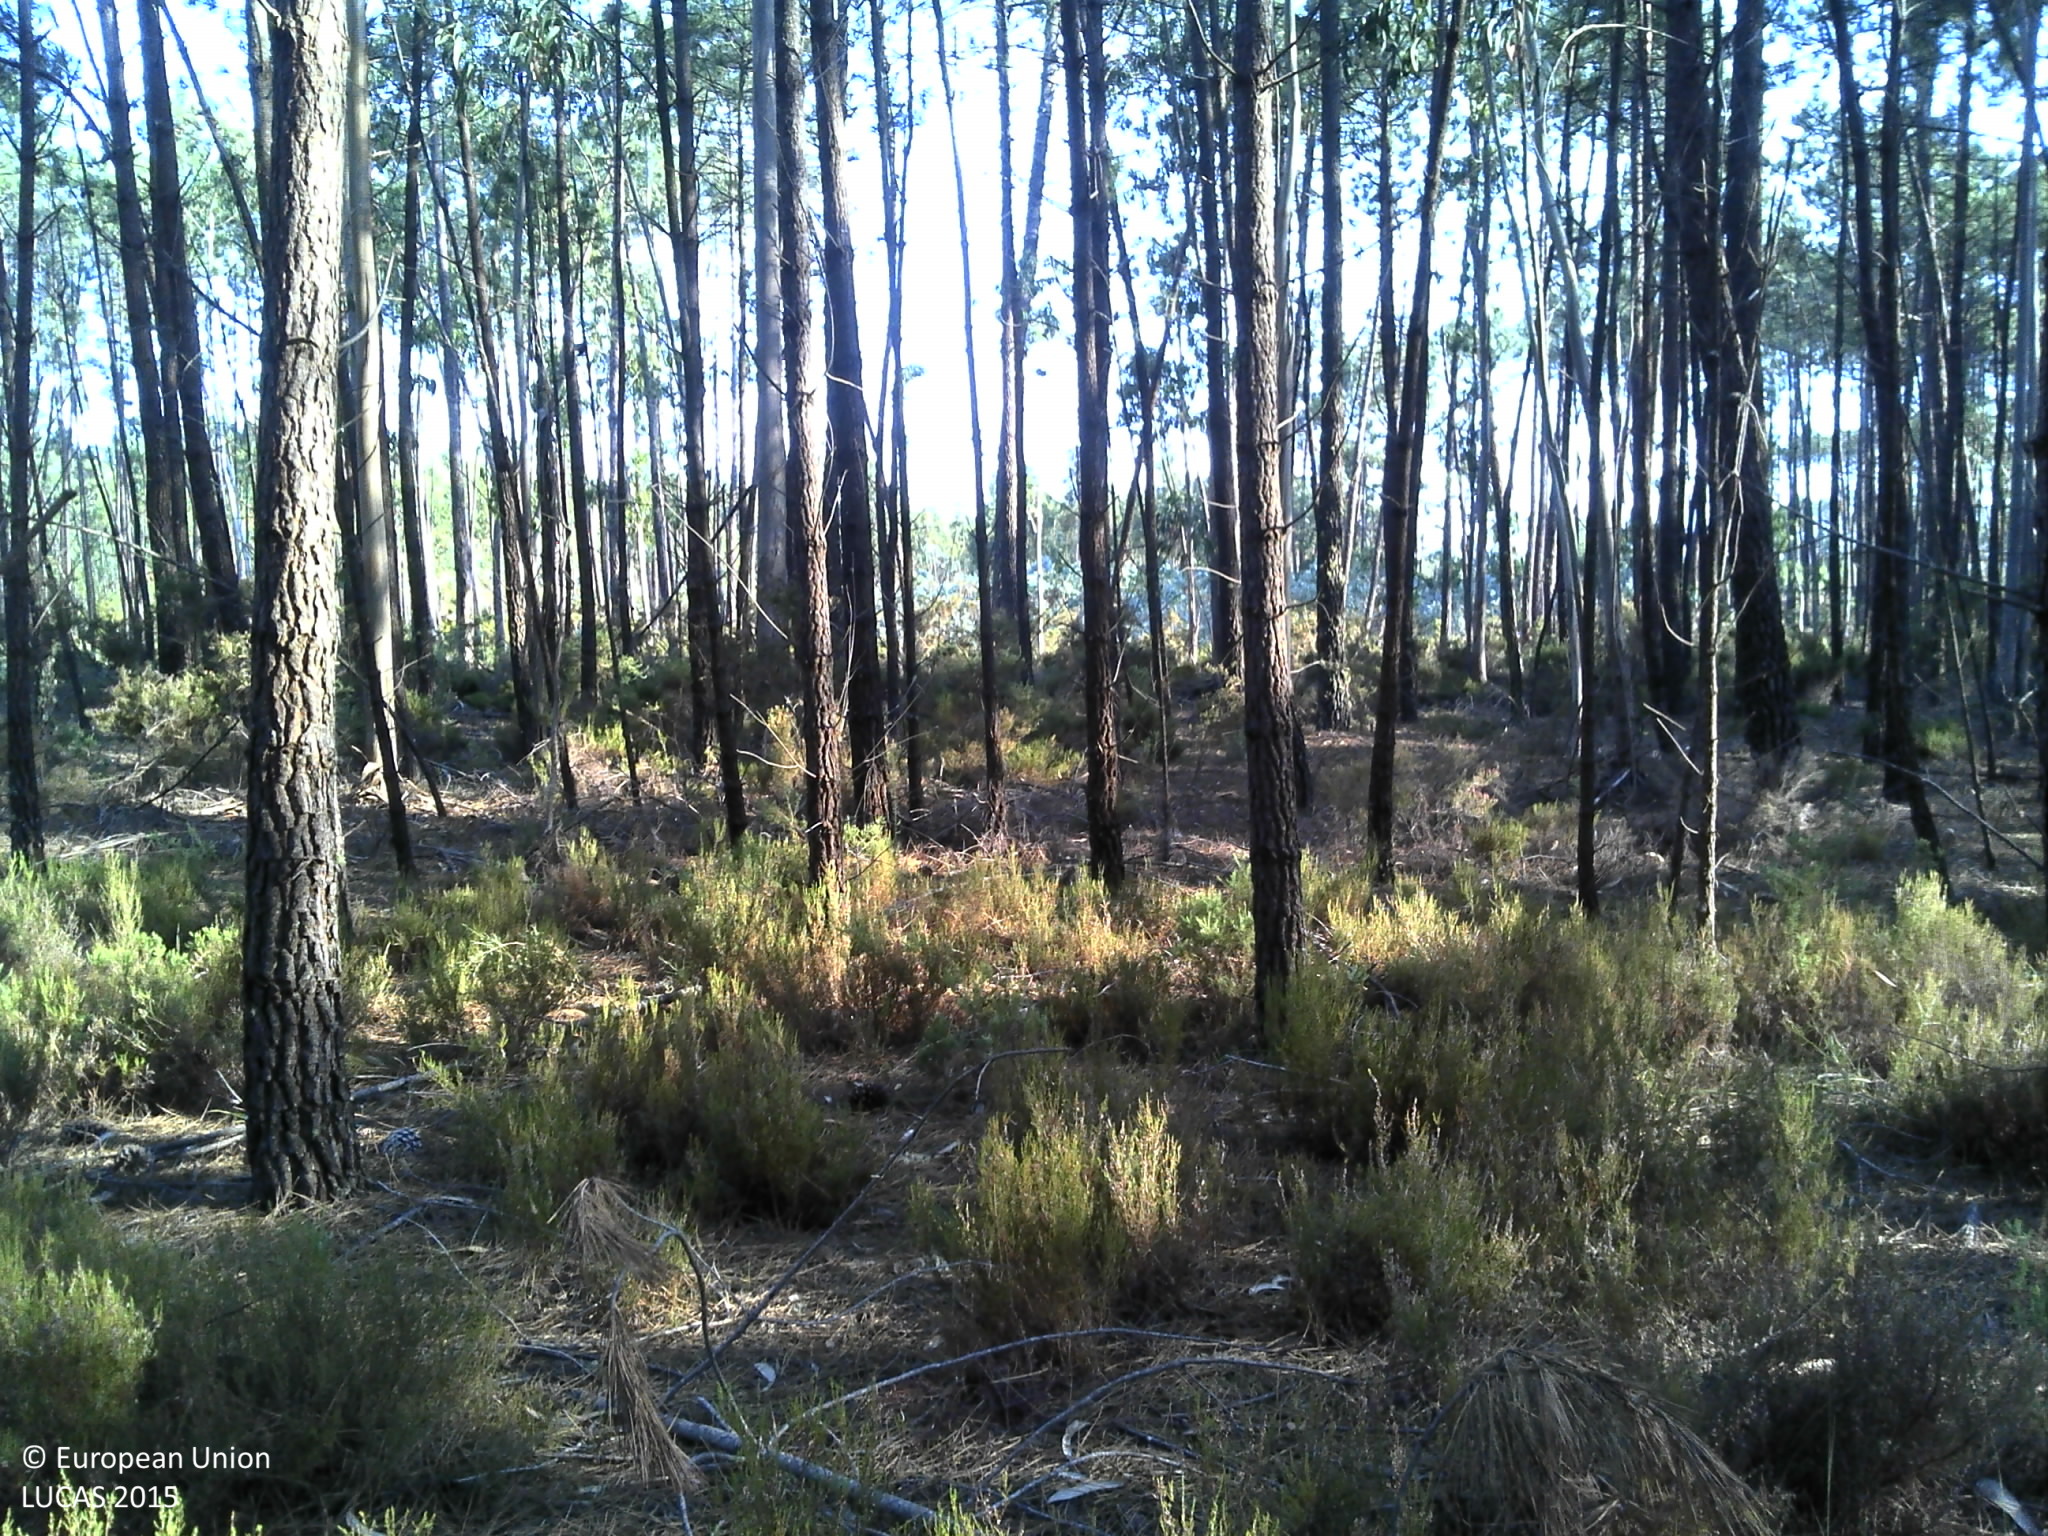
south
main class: Woodland
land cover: Pine dominated coniferous woodland
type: coniferous forest of the mediterranean region
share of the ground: > 75 %
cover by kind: coniferous forest trees 85 %, unconsolidated bare surface 10 %, shrubs 5 %
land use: Forestry
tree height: > 5 m
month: June
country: PT
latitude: 39.7818
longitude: -8.8996
